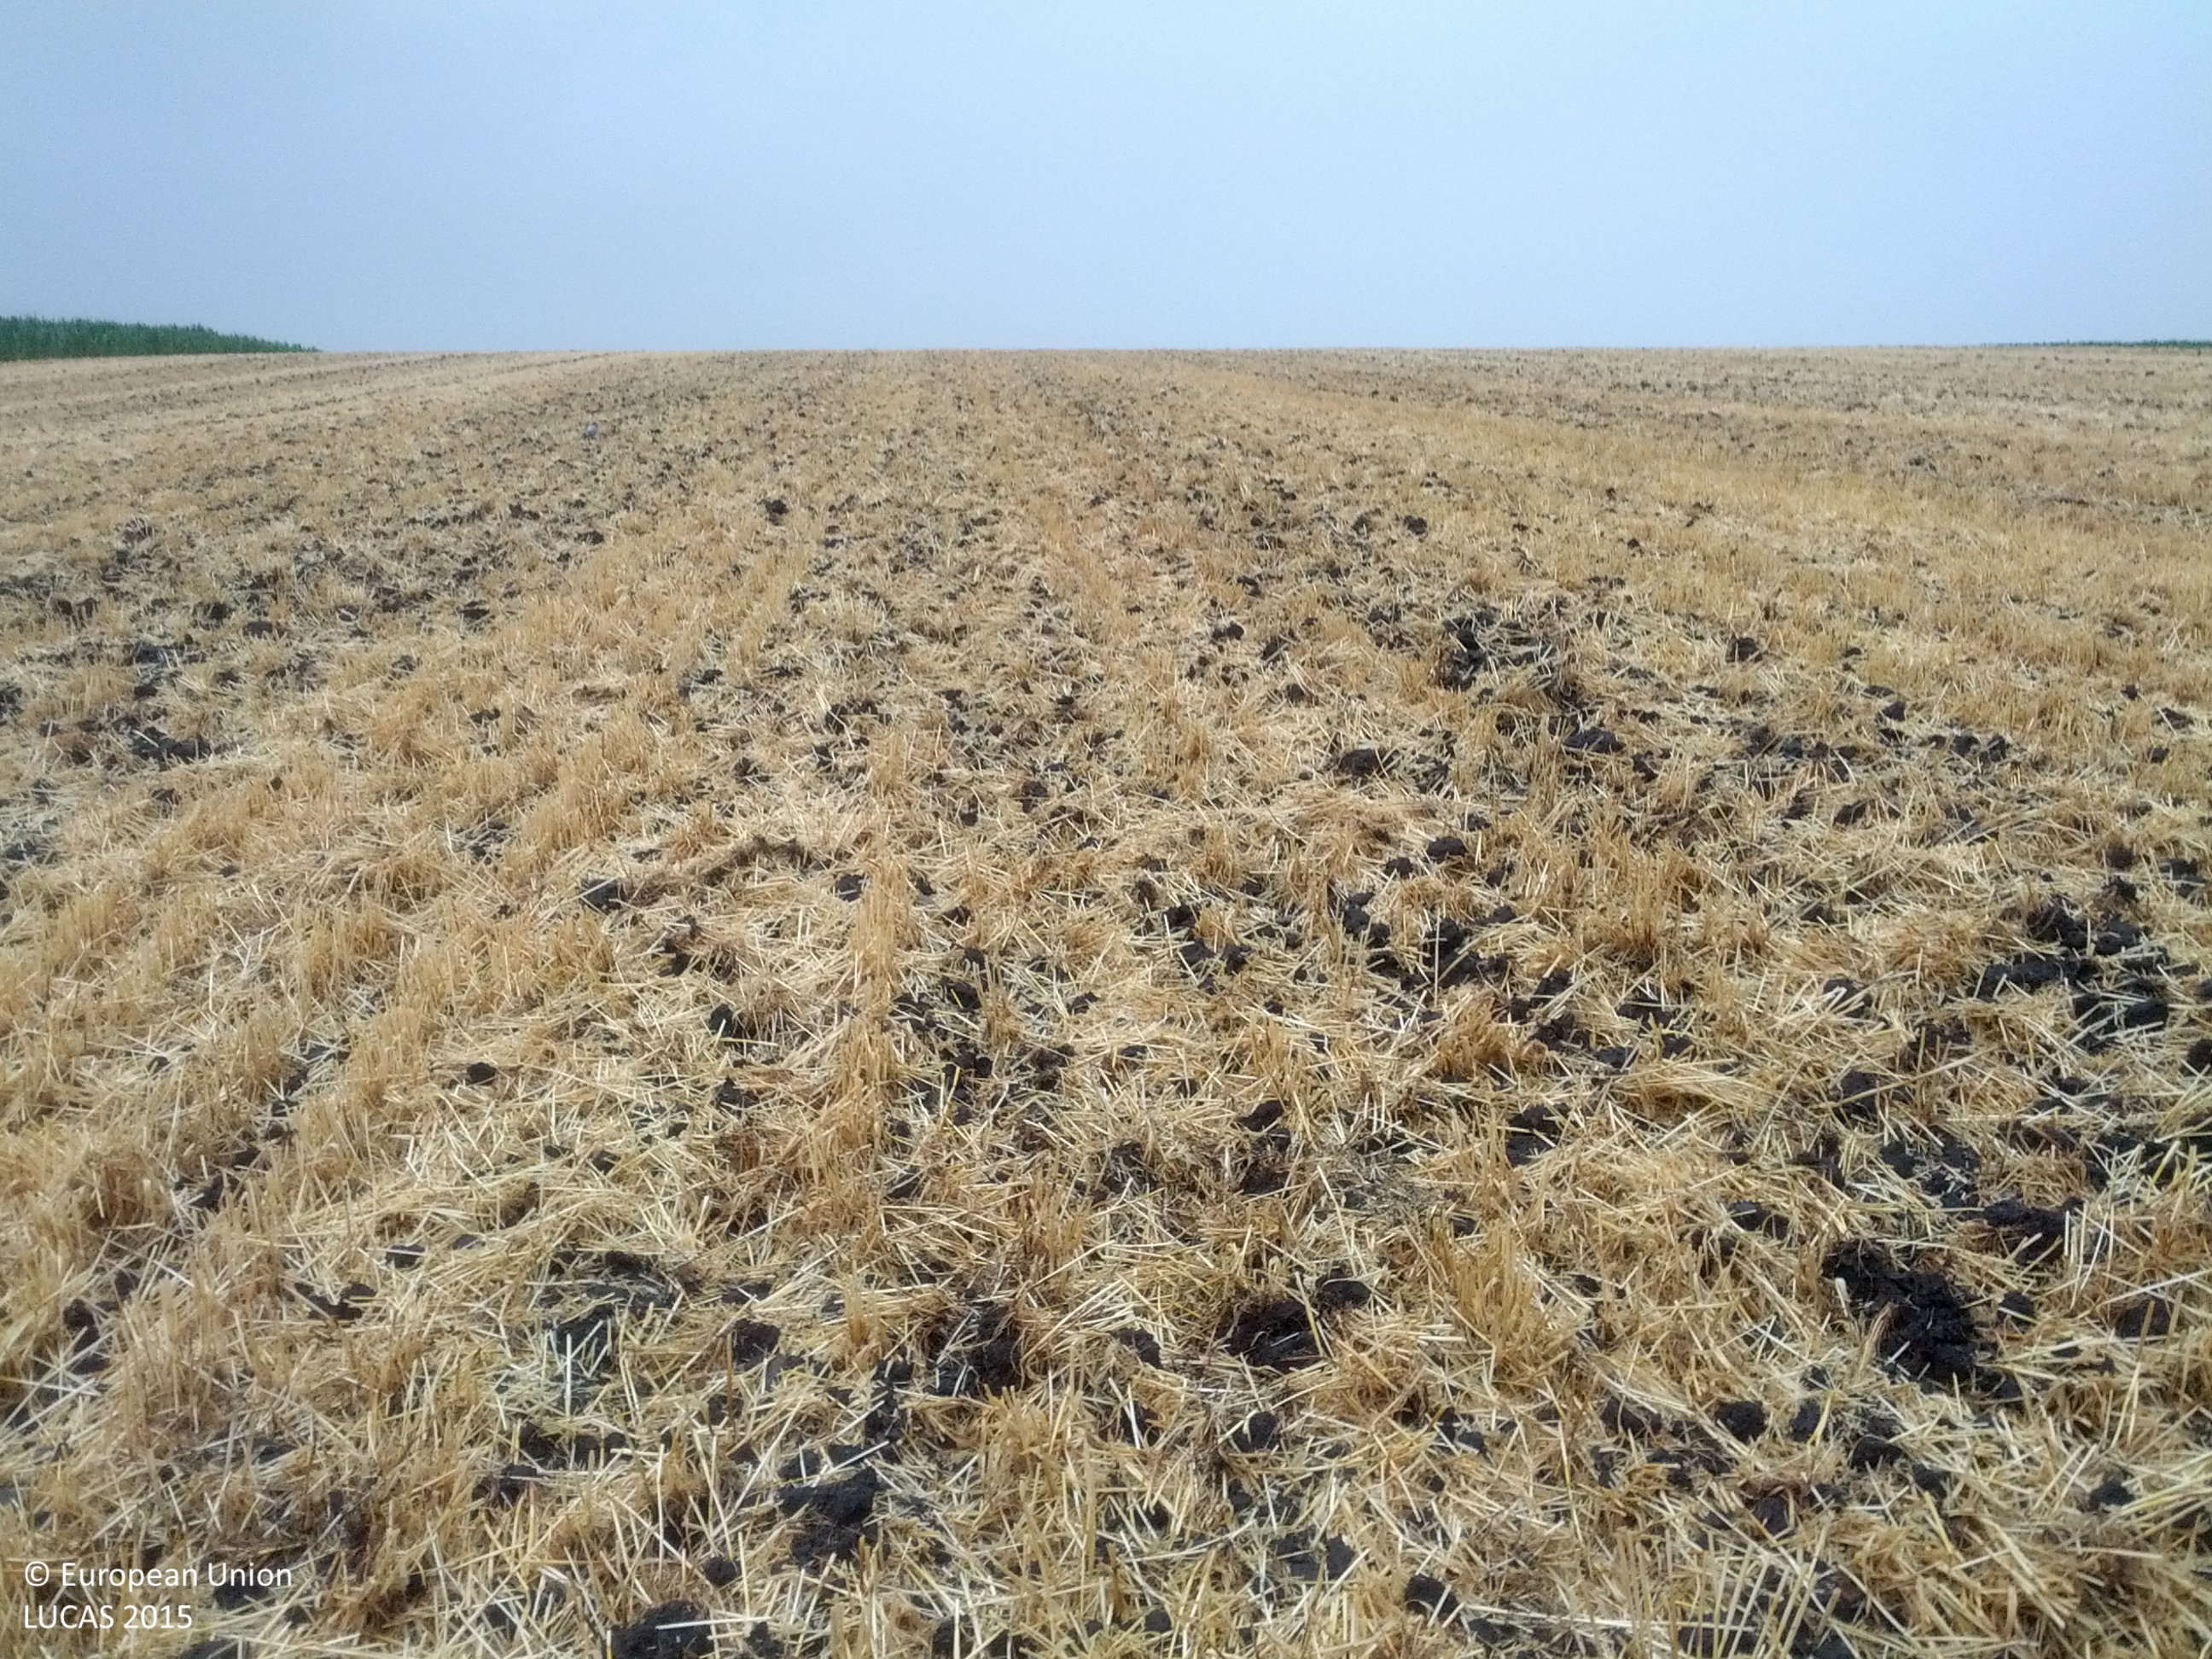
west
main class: Cropland
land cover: Barley
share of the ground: < 10 %
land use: Agriculture (excluding fallow land and kitchen gardens)
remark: Harvested field
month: July
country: AT
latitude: 48.7882
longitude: 16.5263
